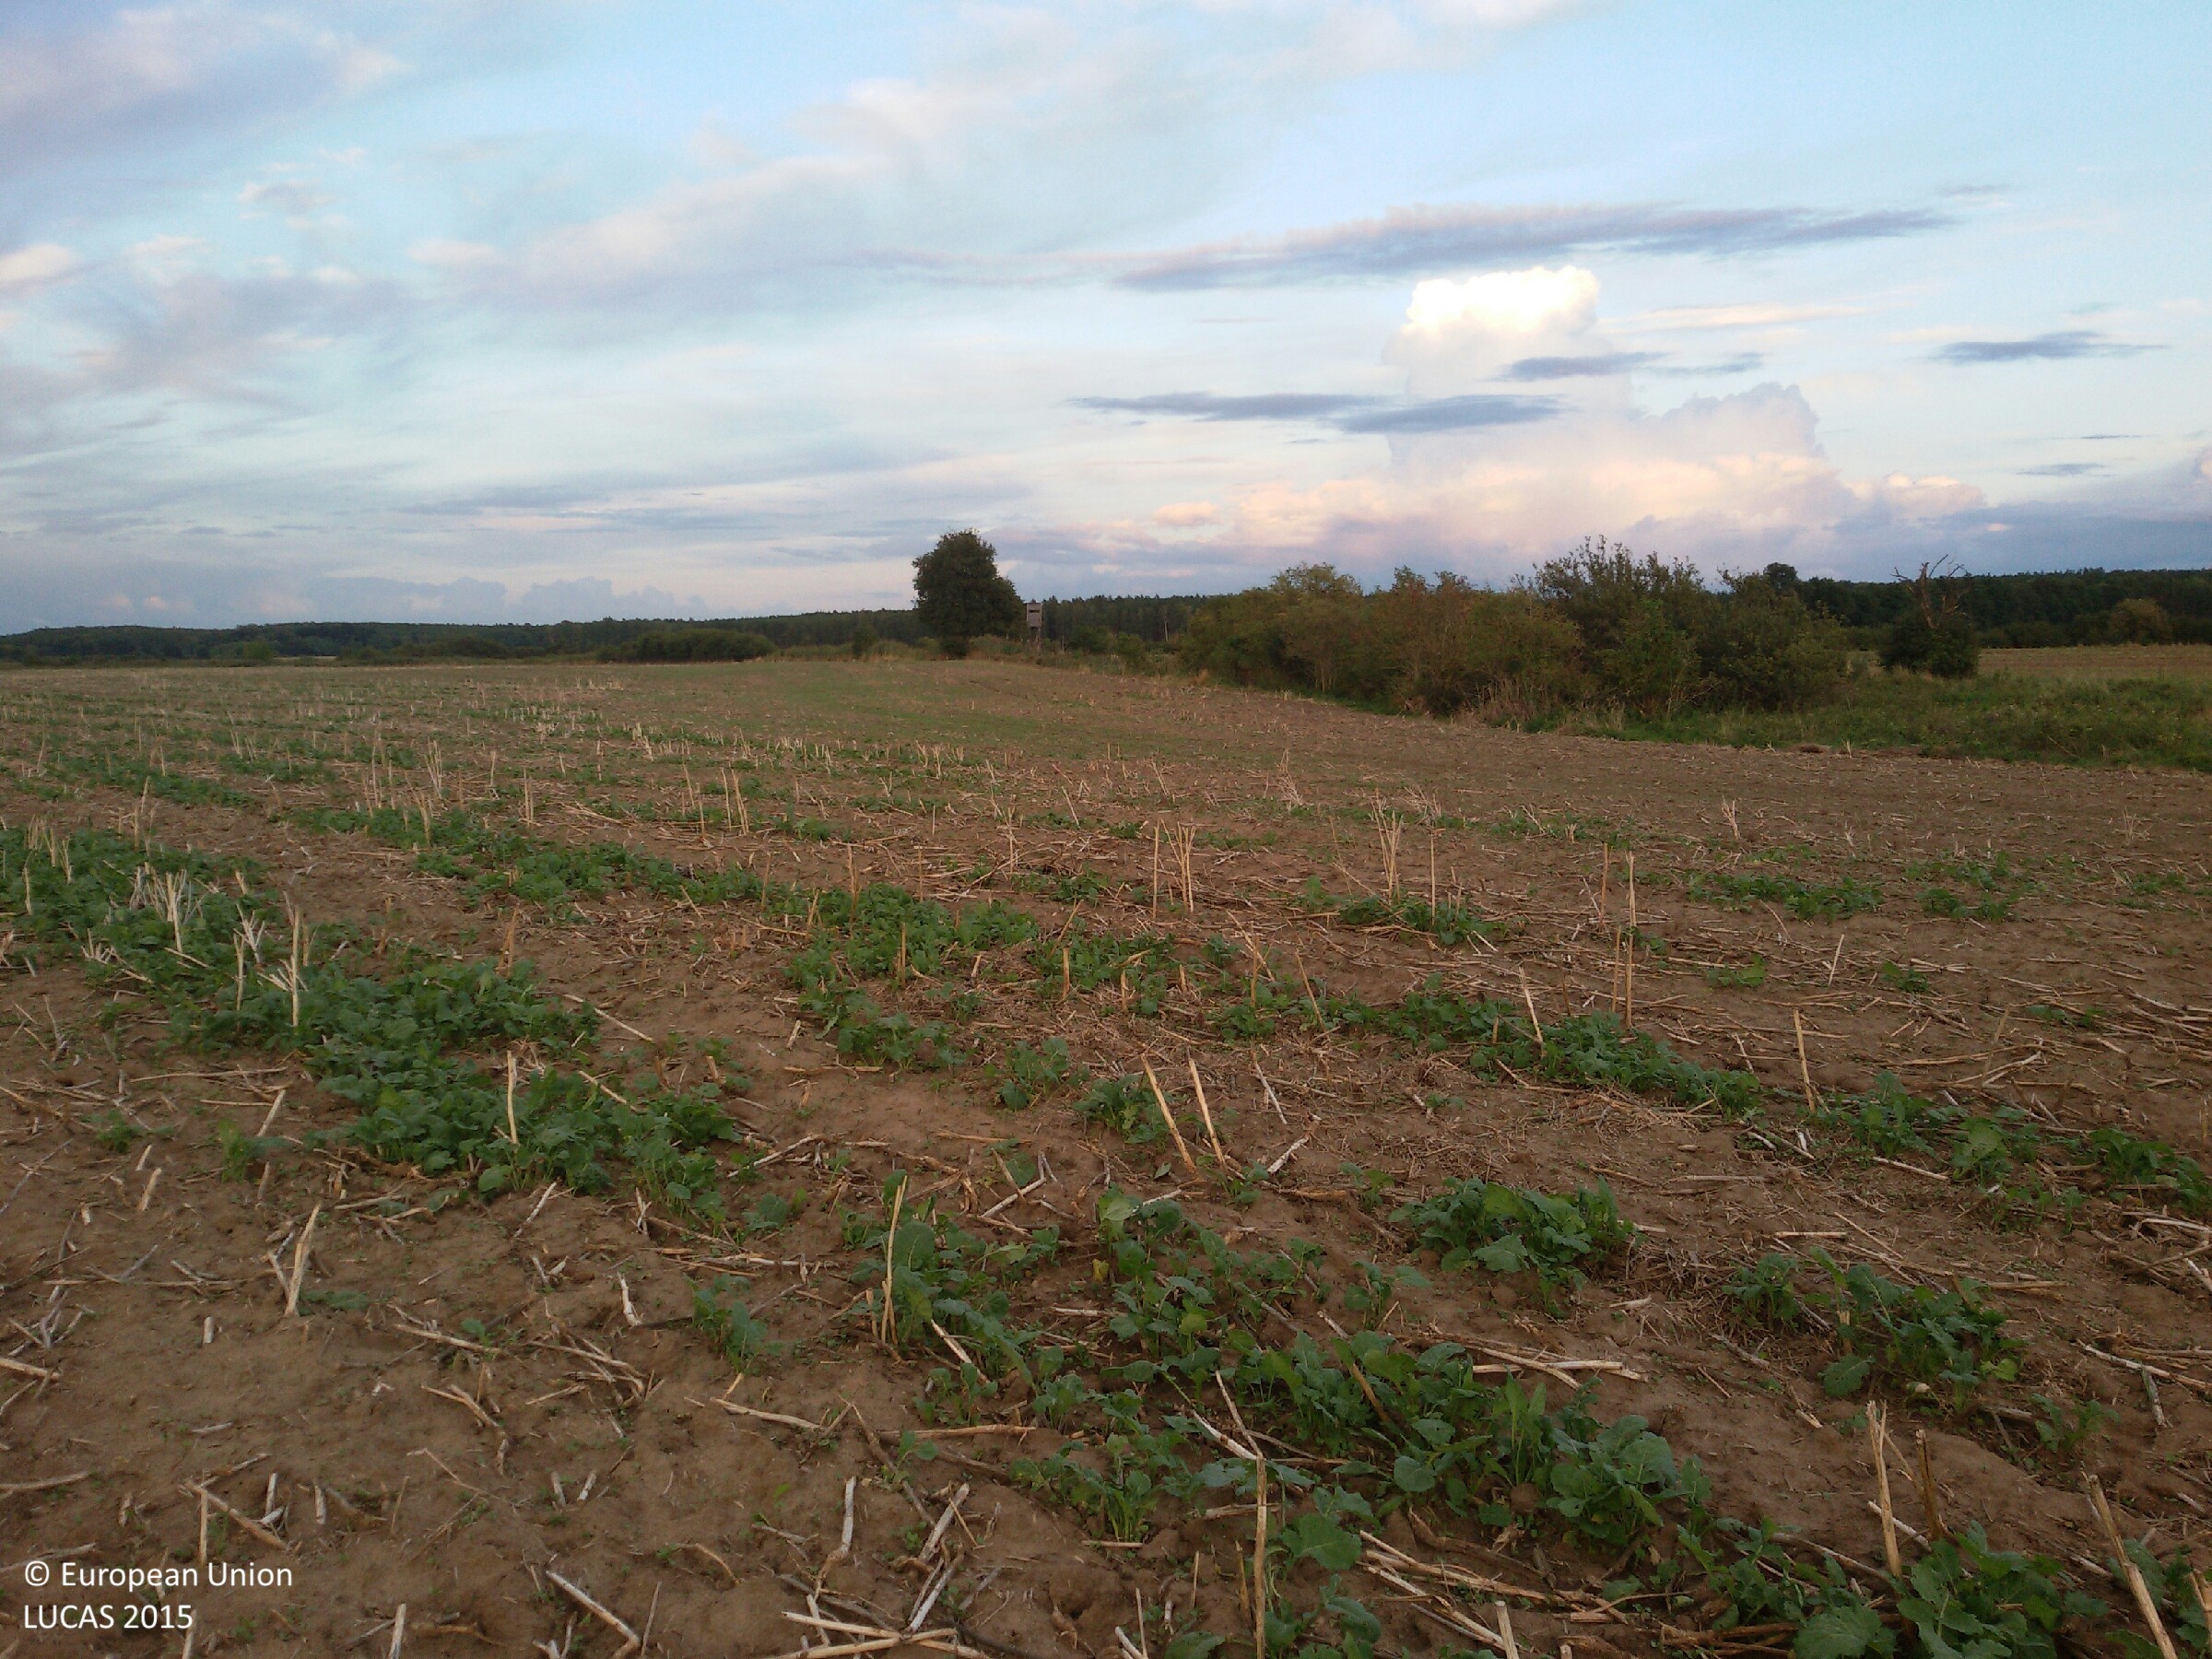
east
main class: Cropland
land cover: Rape and turnip rape
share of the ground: 10 - 25 %
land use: Agriculture (excluding fallow land and kitchen gardens)
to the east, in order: Rape and turnip rape; Shrubland without tree cover; Ditches and canals; Grassland without tree/shrub cover
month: September
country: PL
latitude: 52.1396
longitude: 14.7216
